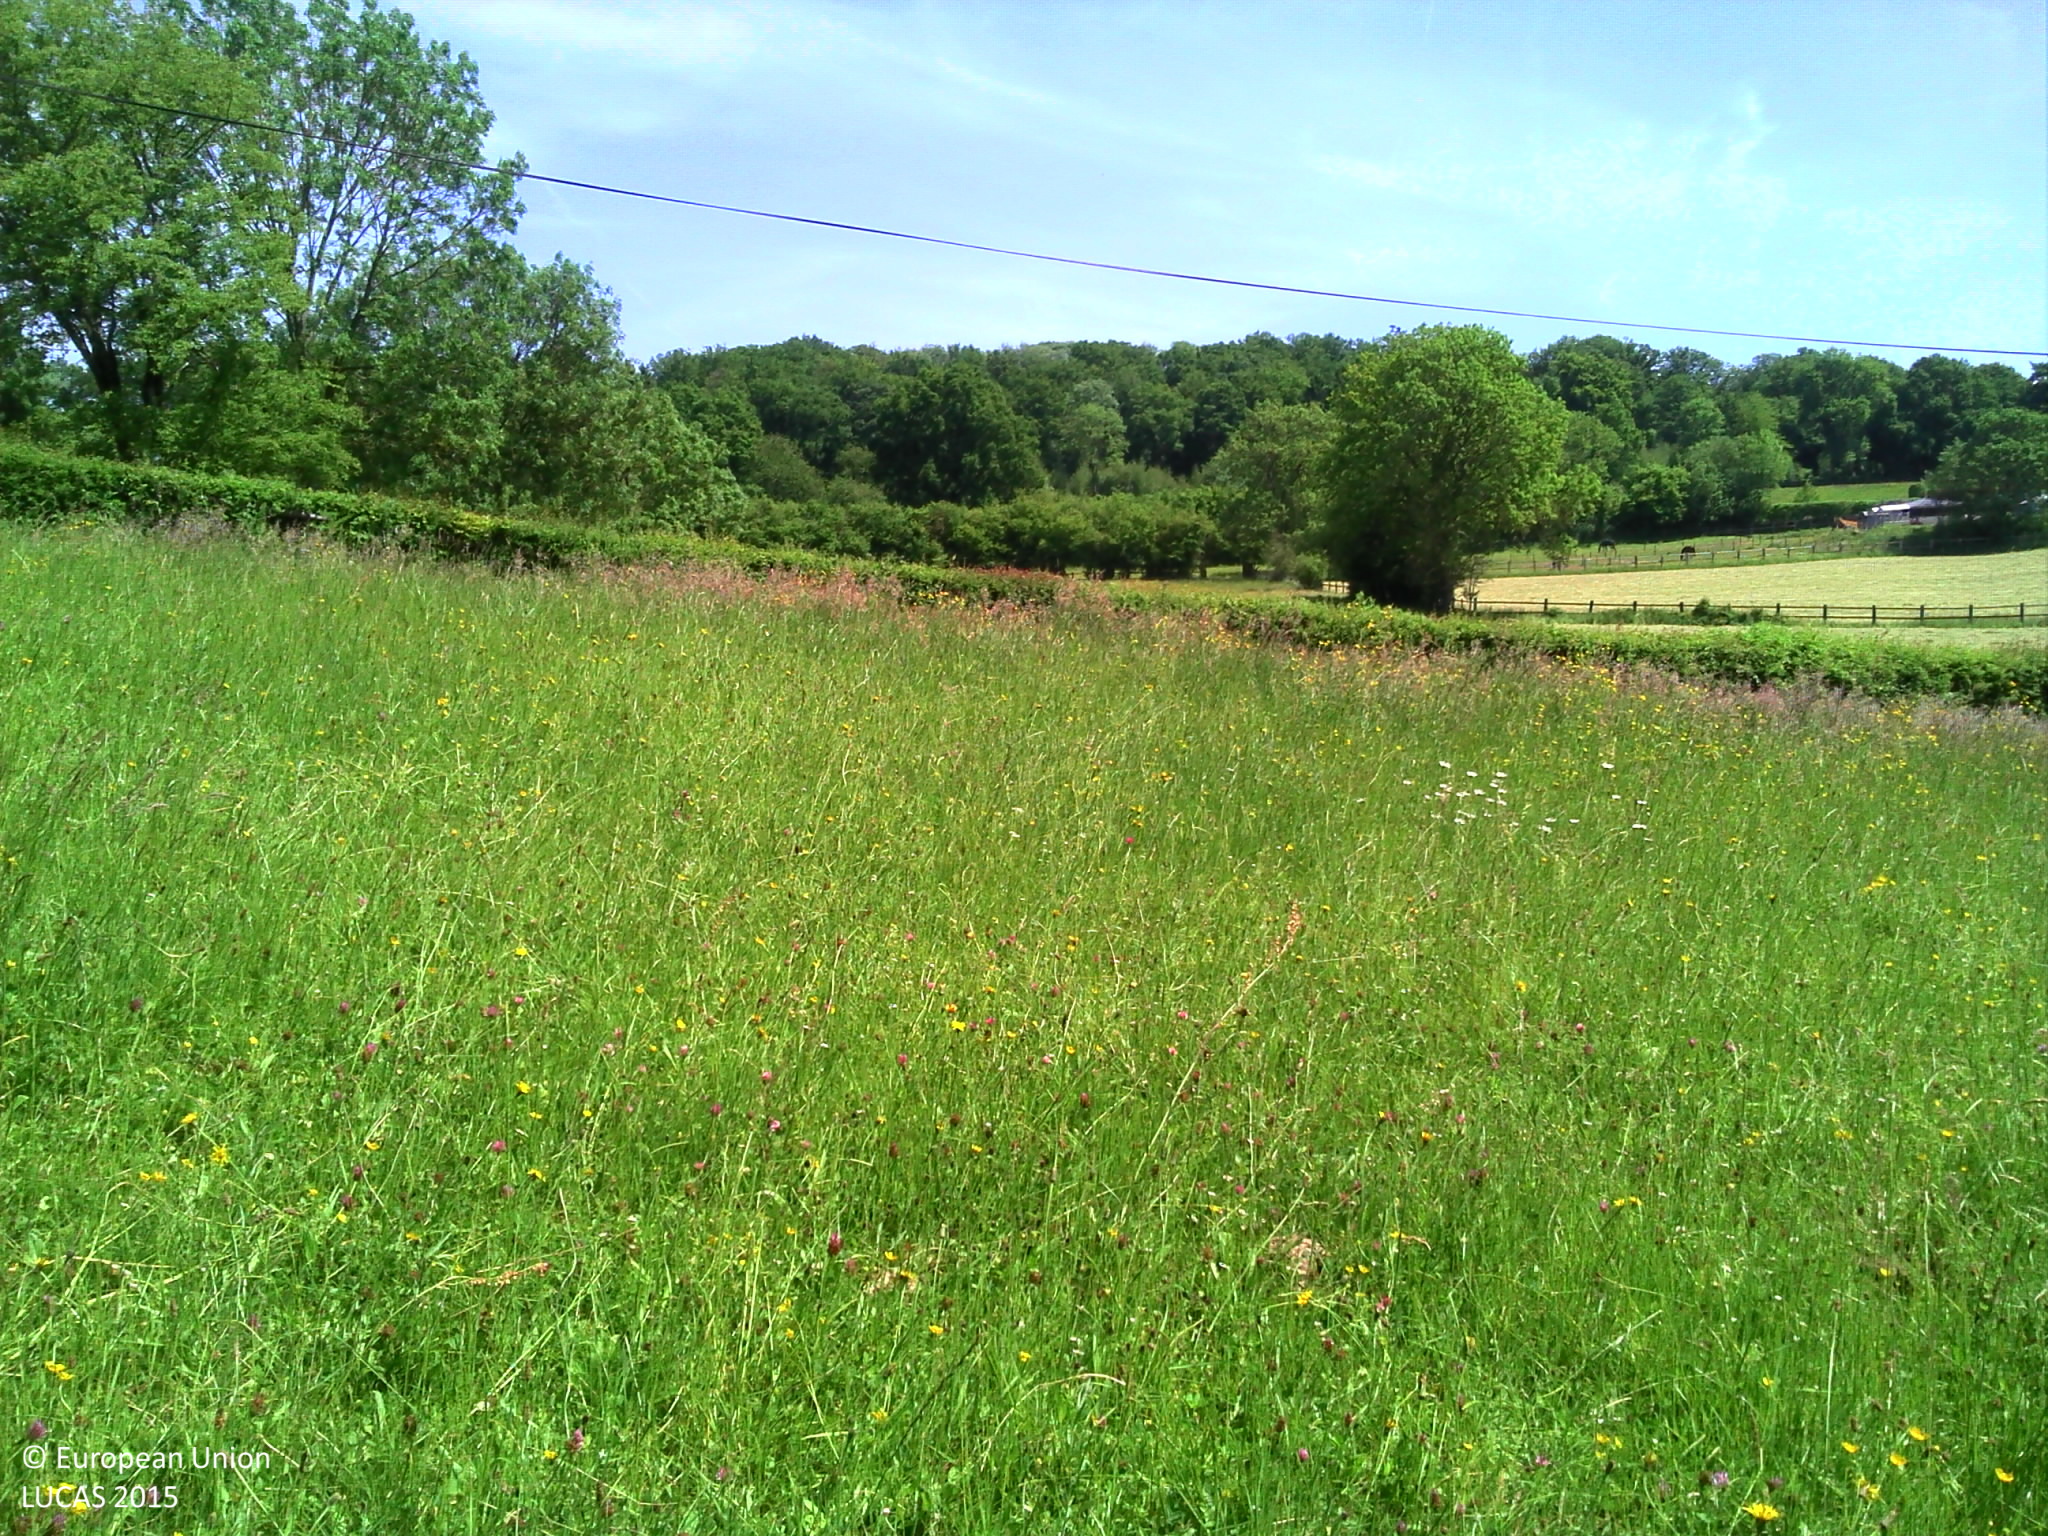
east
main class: Grassland
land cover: Grassland without tree/shrub cover
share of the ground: > 75 %
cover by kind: herbaceous plants 100 %
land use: Agriculture (excluding fallow land and kitchen gardens)
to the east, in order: Grassland without tree/shrub cover; Fences; Managed hedges; Grass margins; Paved roads, cycling and walking lanes; Grass margins; Managed hedges; Fences; Grassland with sparse tree/shrub cover; Fences; Grass margins; Grassland without tree/shrub cover; Grass margins; Fences; Inland fresh water bodies; Broadleaved woodland; Fences; Managed hedges; Fences; Grassland without tree/shrub cover; Fences; Broadleaved woodland
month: June
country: BE
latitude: 50.5003
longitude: 5.7268
